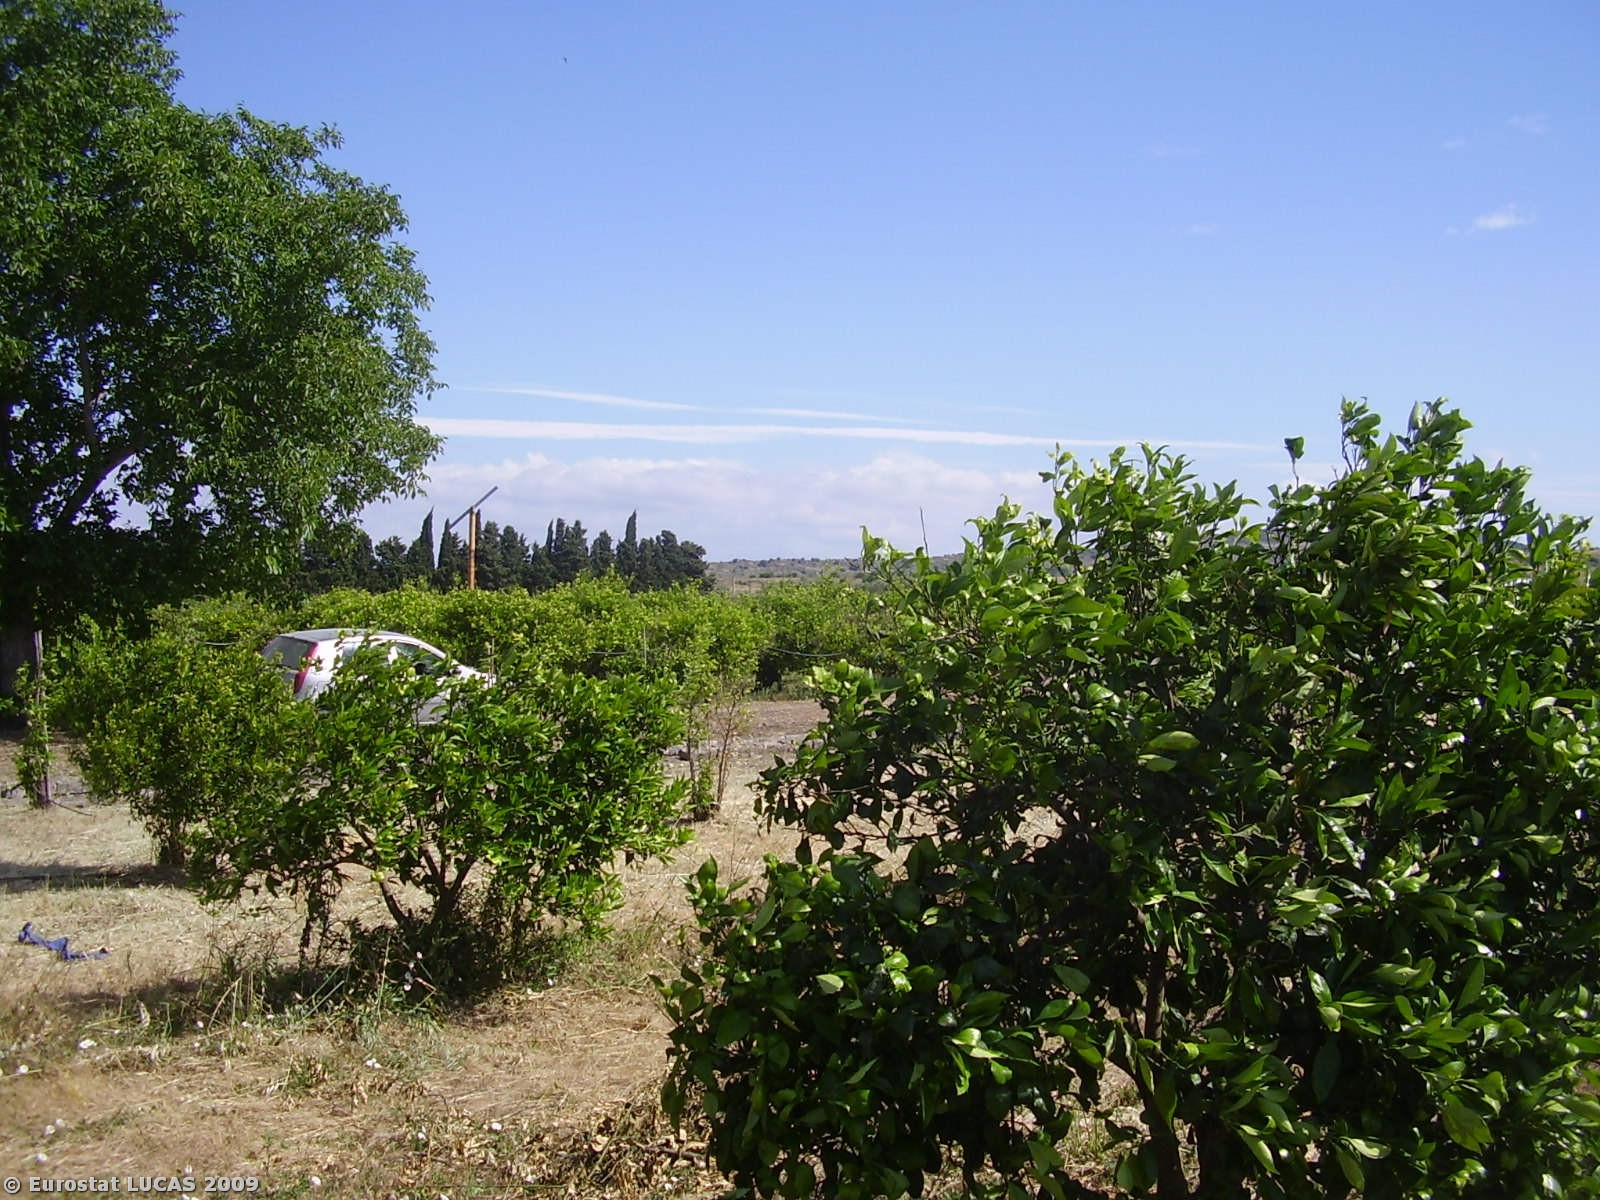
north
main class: Cropland
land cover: Oranges
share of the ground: 50 - 75 %
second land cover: Spontaneously vegetated surfaces
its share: > 75 %
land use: Agriculture (excluding fallow land and kitchen gardens)
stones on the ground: < 10 %
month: June
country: IT
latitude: 37.2170
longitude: 14.9773
